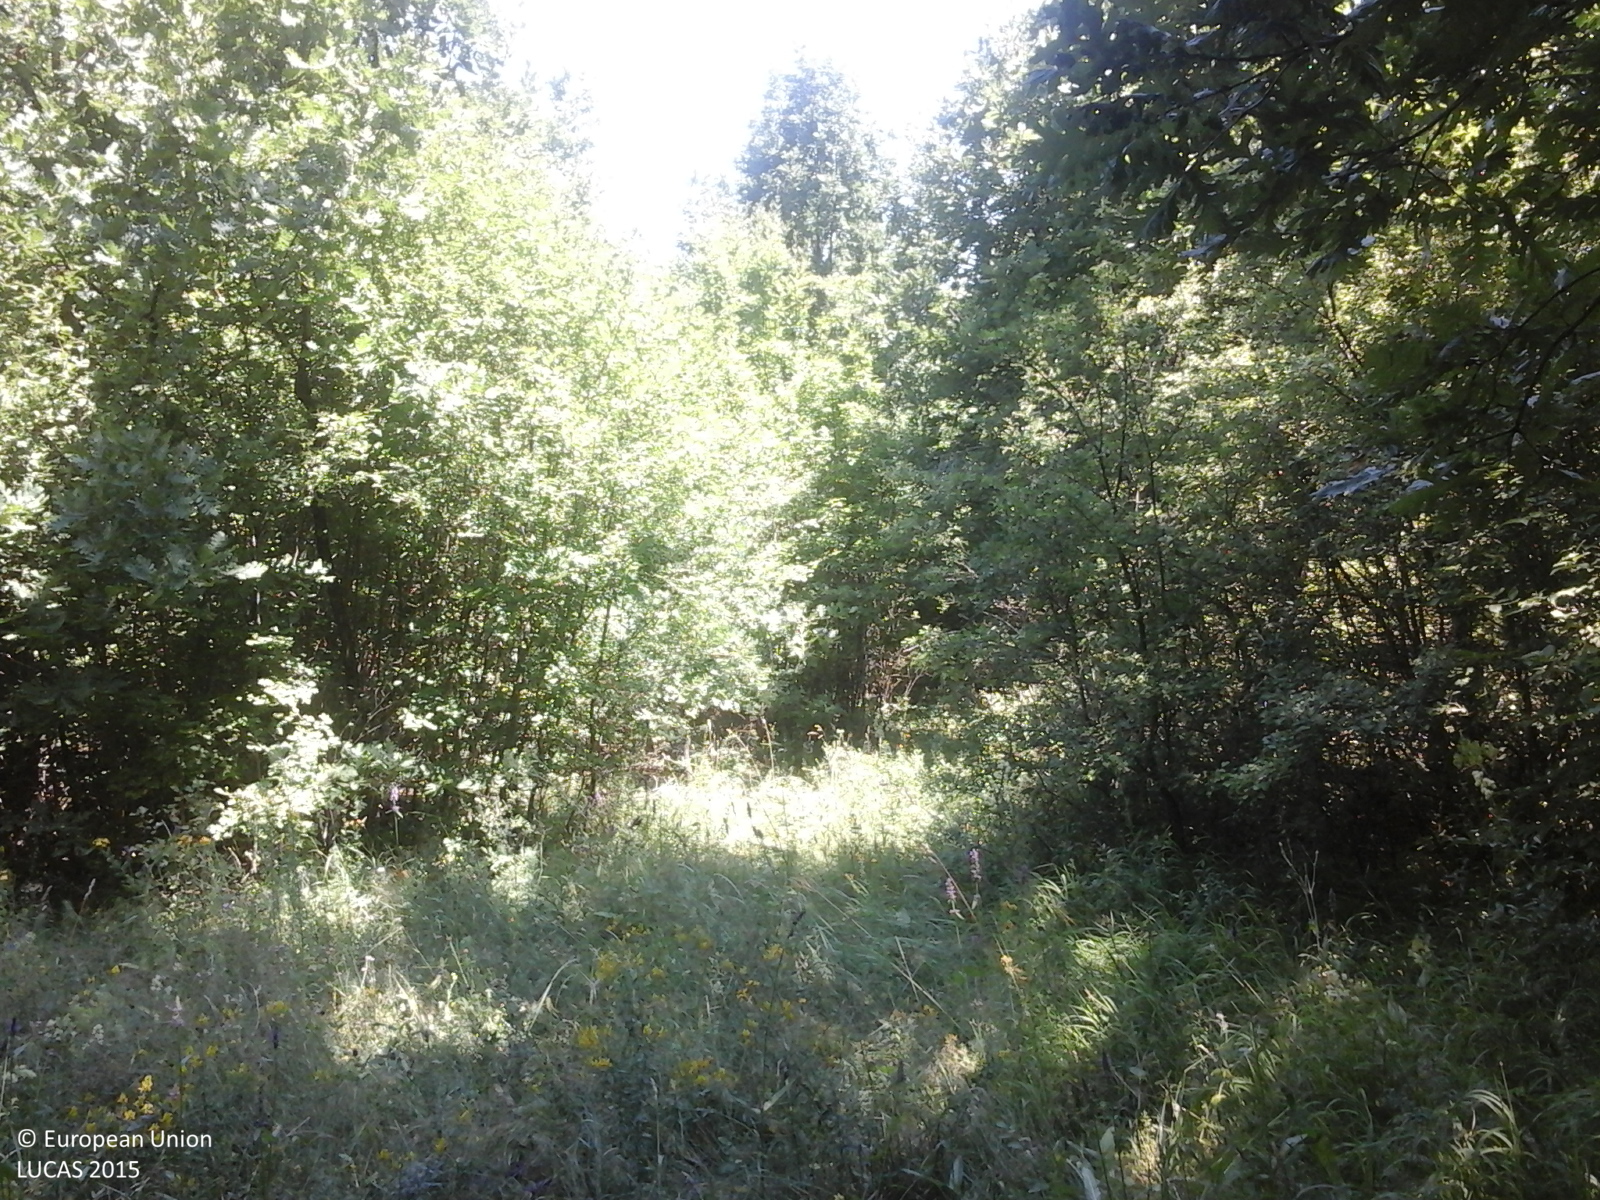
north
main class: Woodland
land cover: Broadleaved woodland
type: acidophilous oak and oak-birch forest
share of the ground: > 75 %
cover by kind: broadleaved forest trees 100 %
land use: Forestry
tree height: > 5 m
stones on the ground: < 10 %
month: July
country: RO
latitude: 44.6630
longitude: 24.3594
